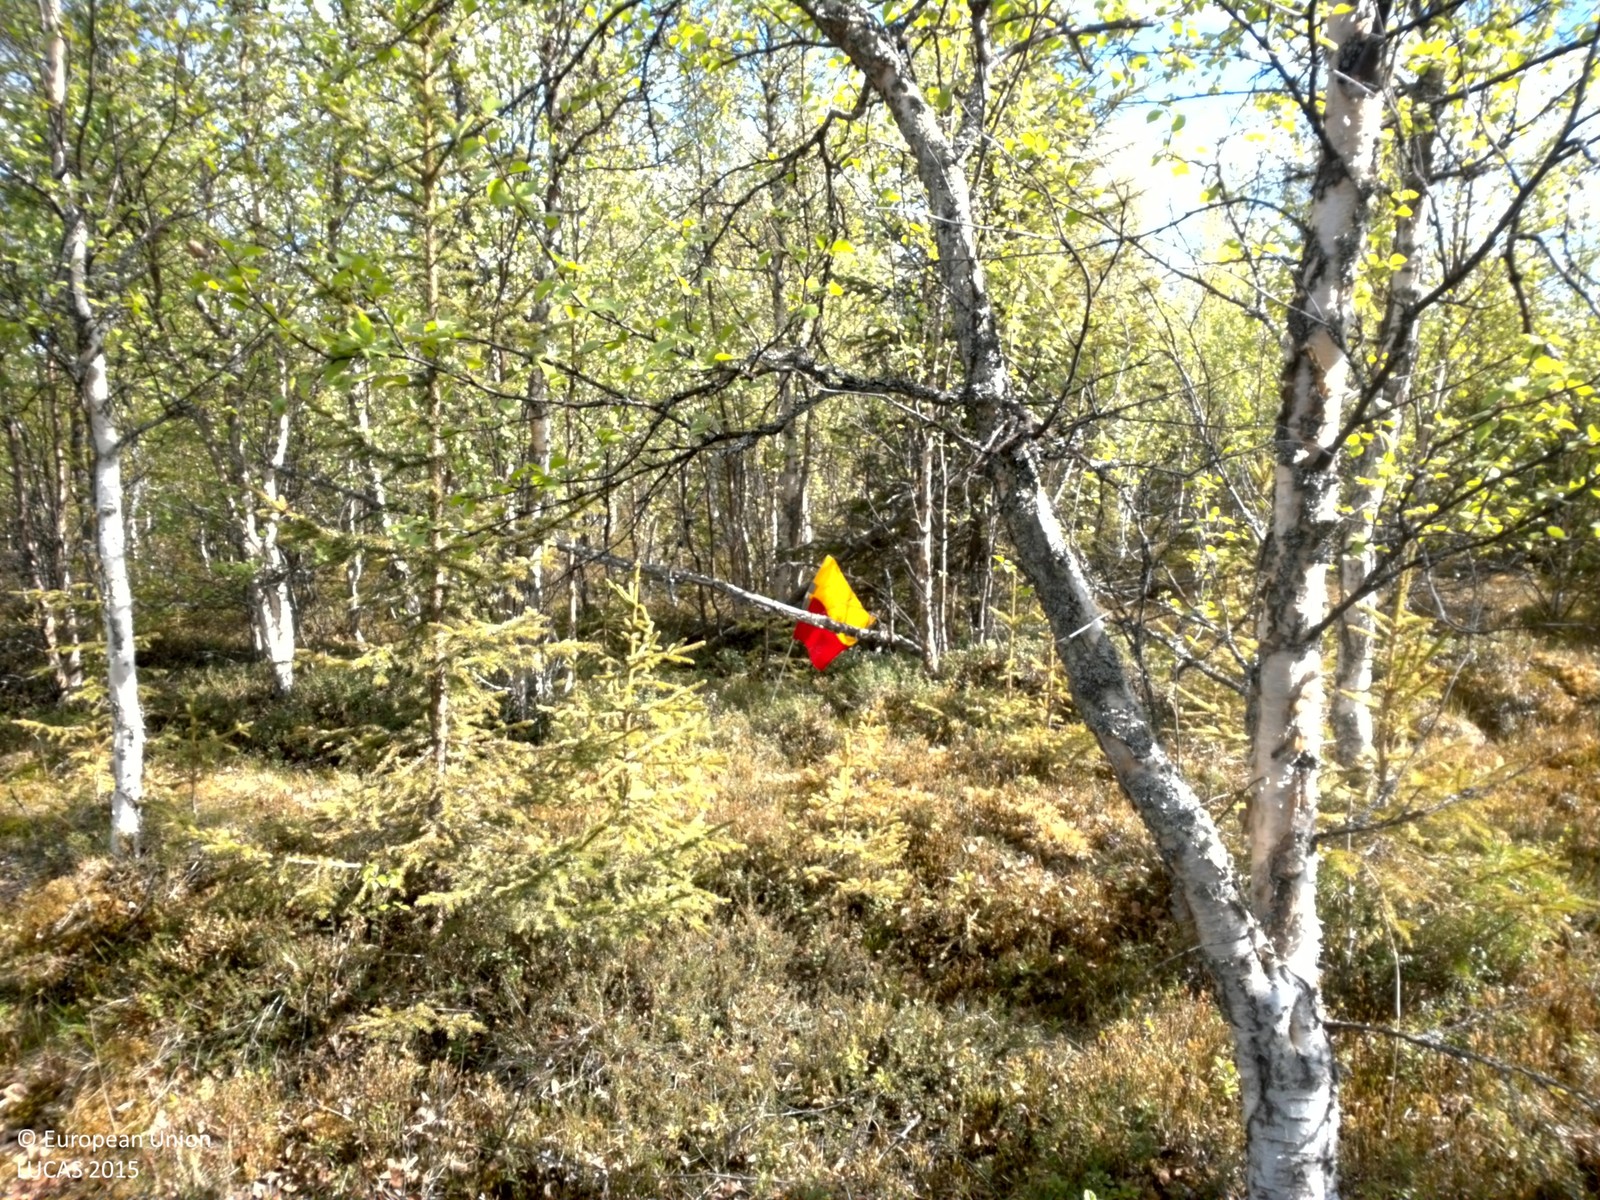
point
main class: Woodland
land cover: Broadleaved woodland
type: boreal forest
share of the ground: 50 - 75 %
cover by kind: broadleaved forest trees 65 %, herbaceous plants 15 %, coniferous forest trees 10 %, lichens and mosses 10 %
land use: Forestry
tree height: < 5 m
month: June
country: SE
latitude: 64.4081
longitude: 17.3752
